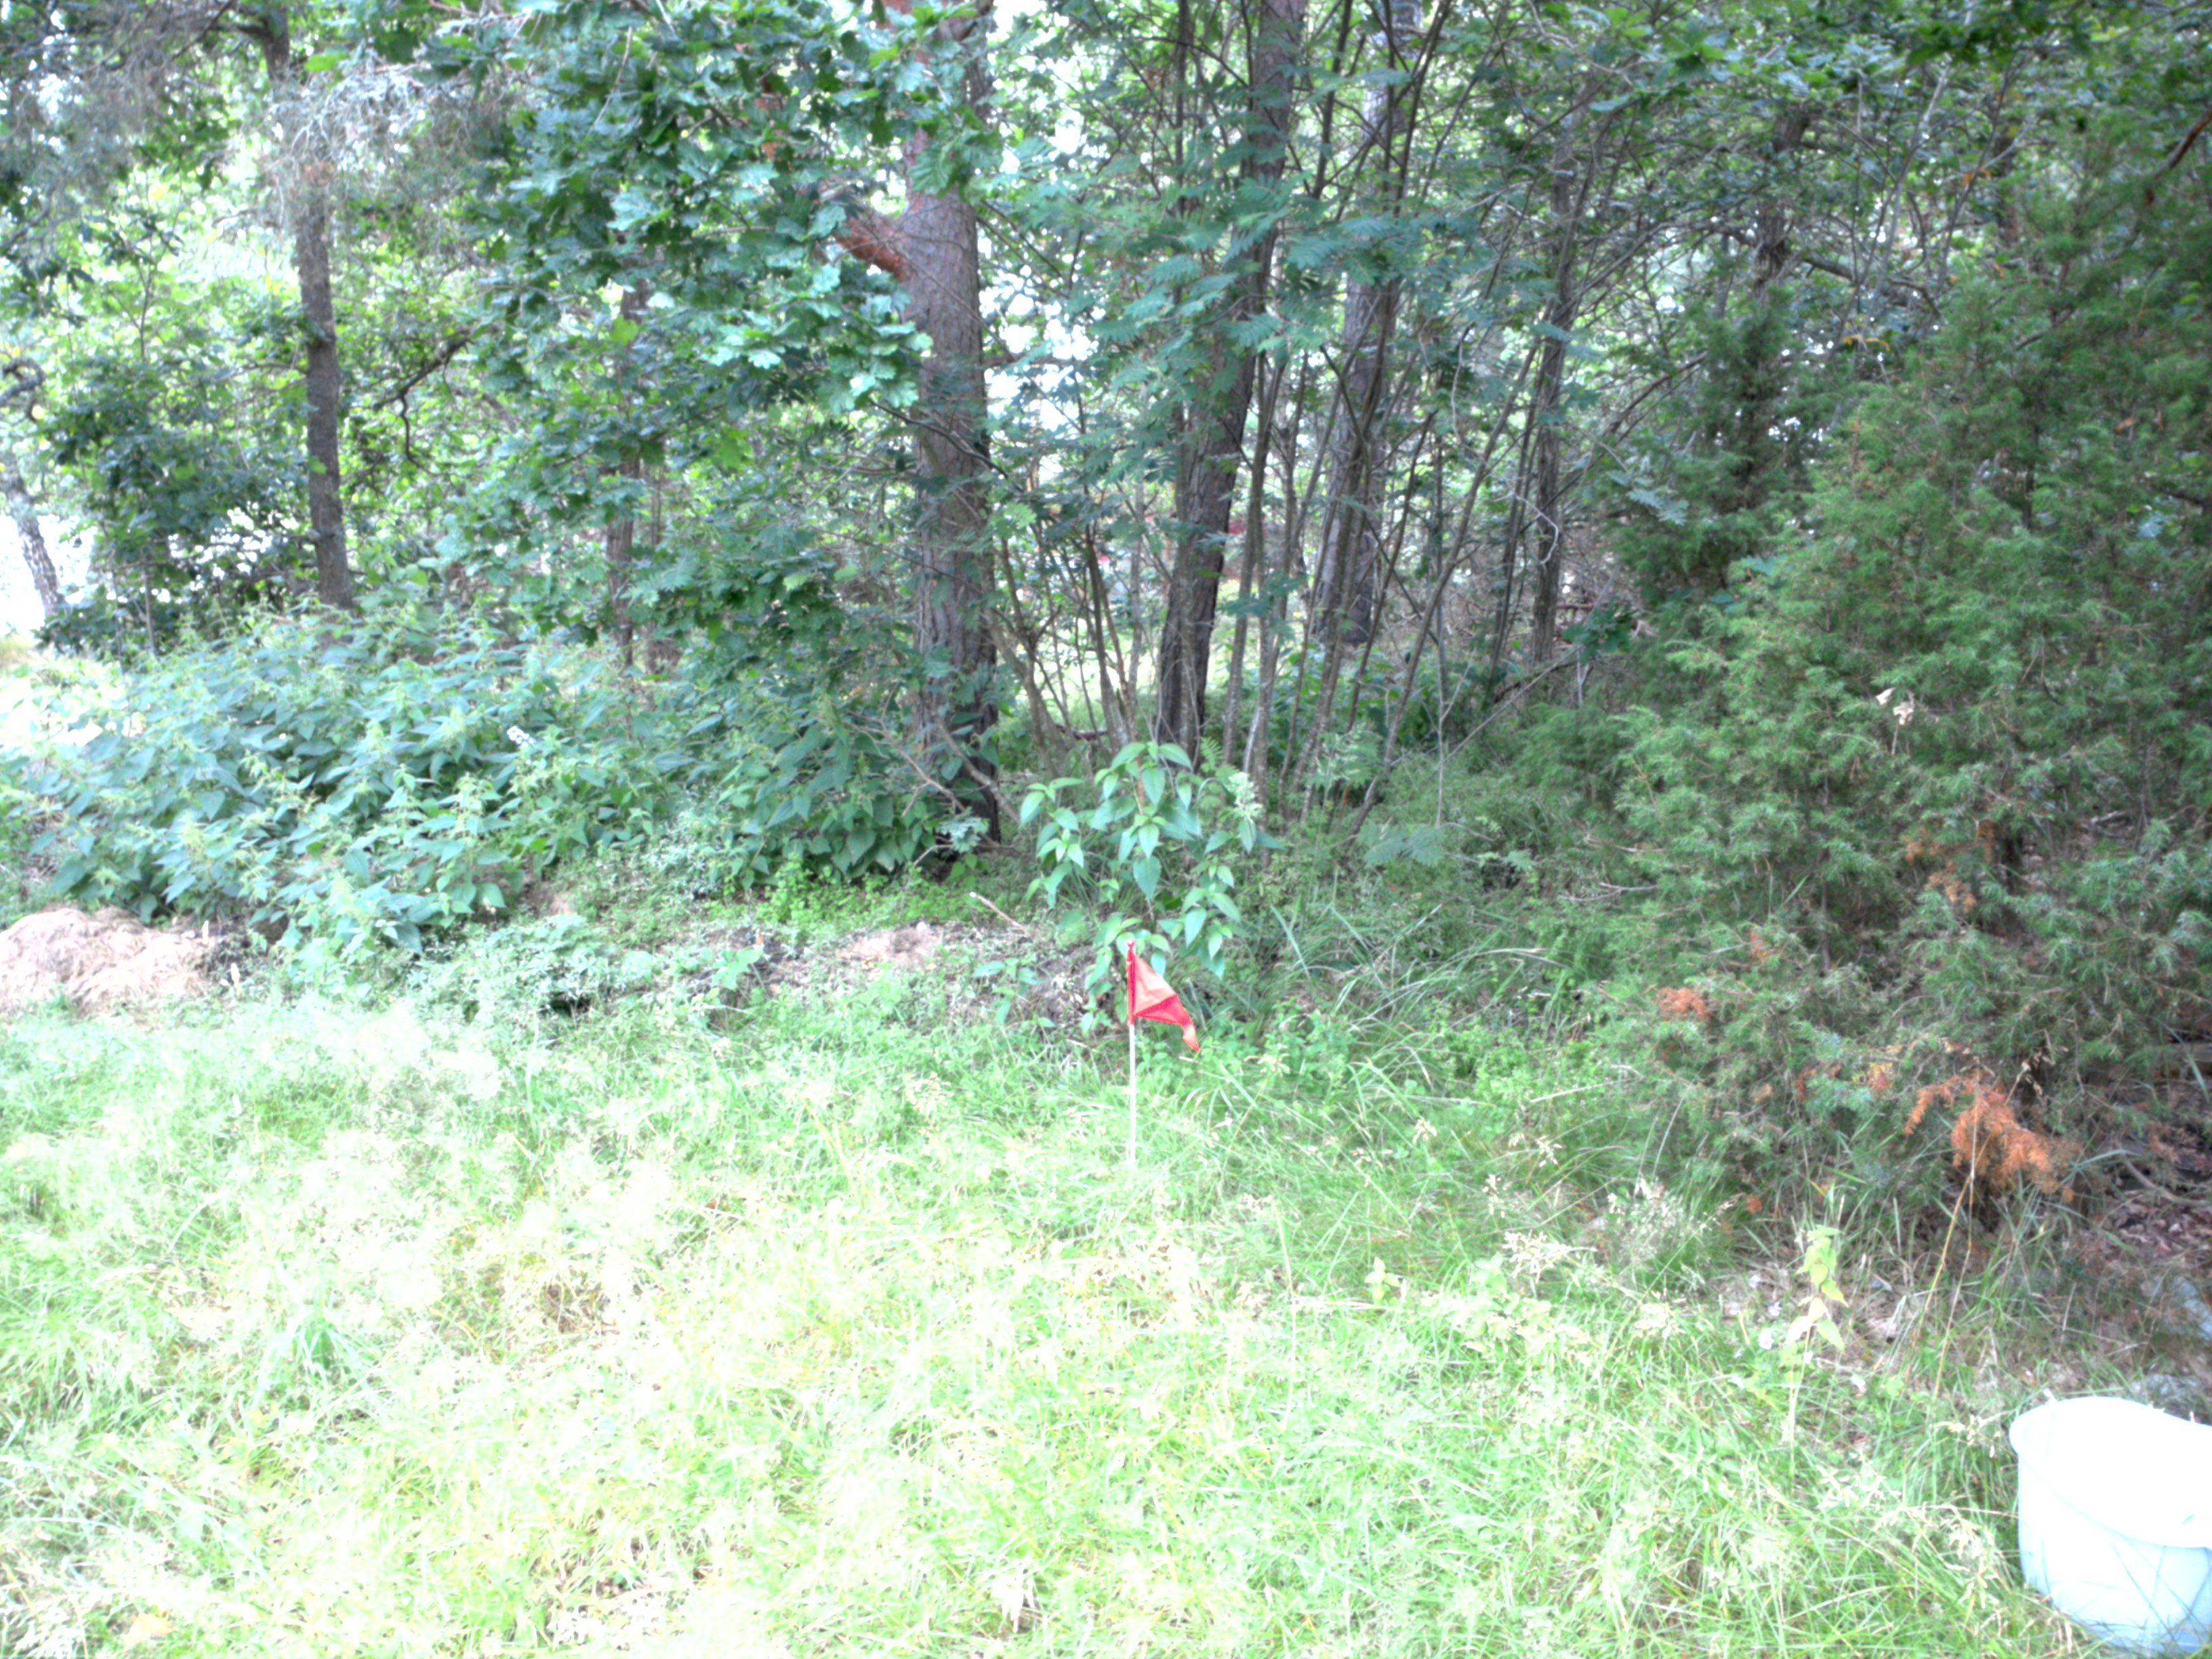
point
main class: Woodland
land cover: Broadleaved woodland
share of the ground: 50 - 75 %
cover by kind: broadleaved forest trees 55 %, herbaceous plants 35 %, coniferous forest trees 10 %
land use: Residential
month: July
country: SE
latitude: 59.1347
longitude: 18.3720
